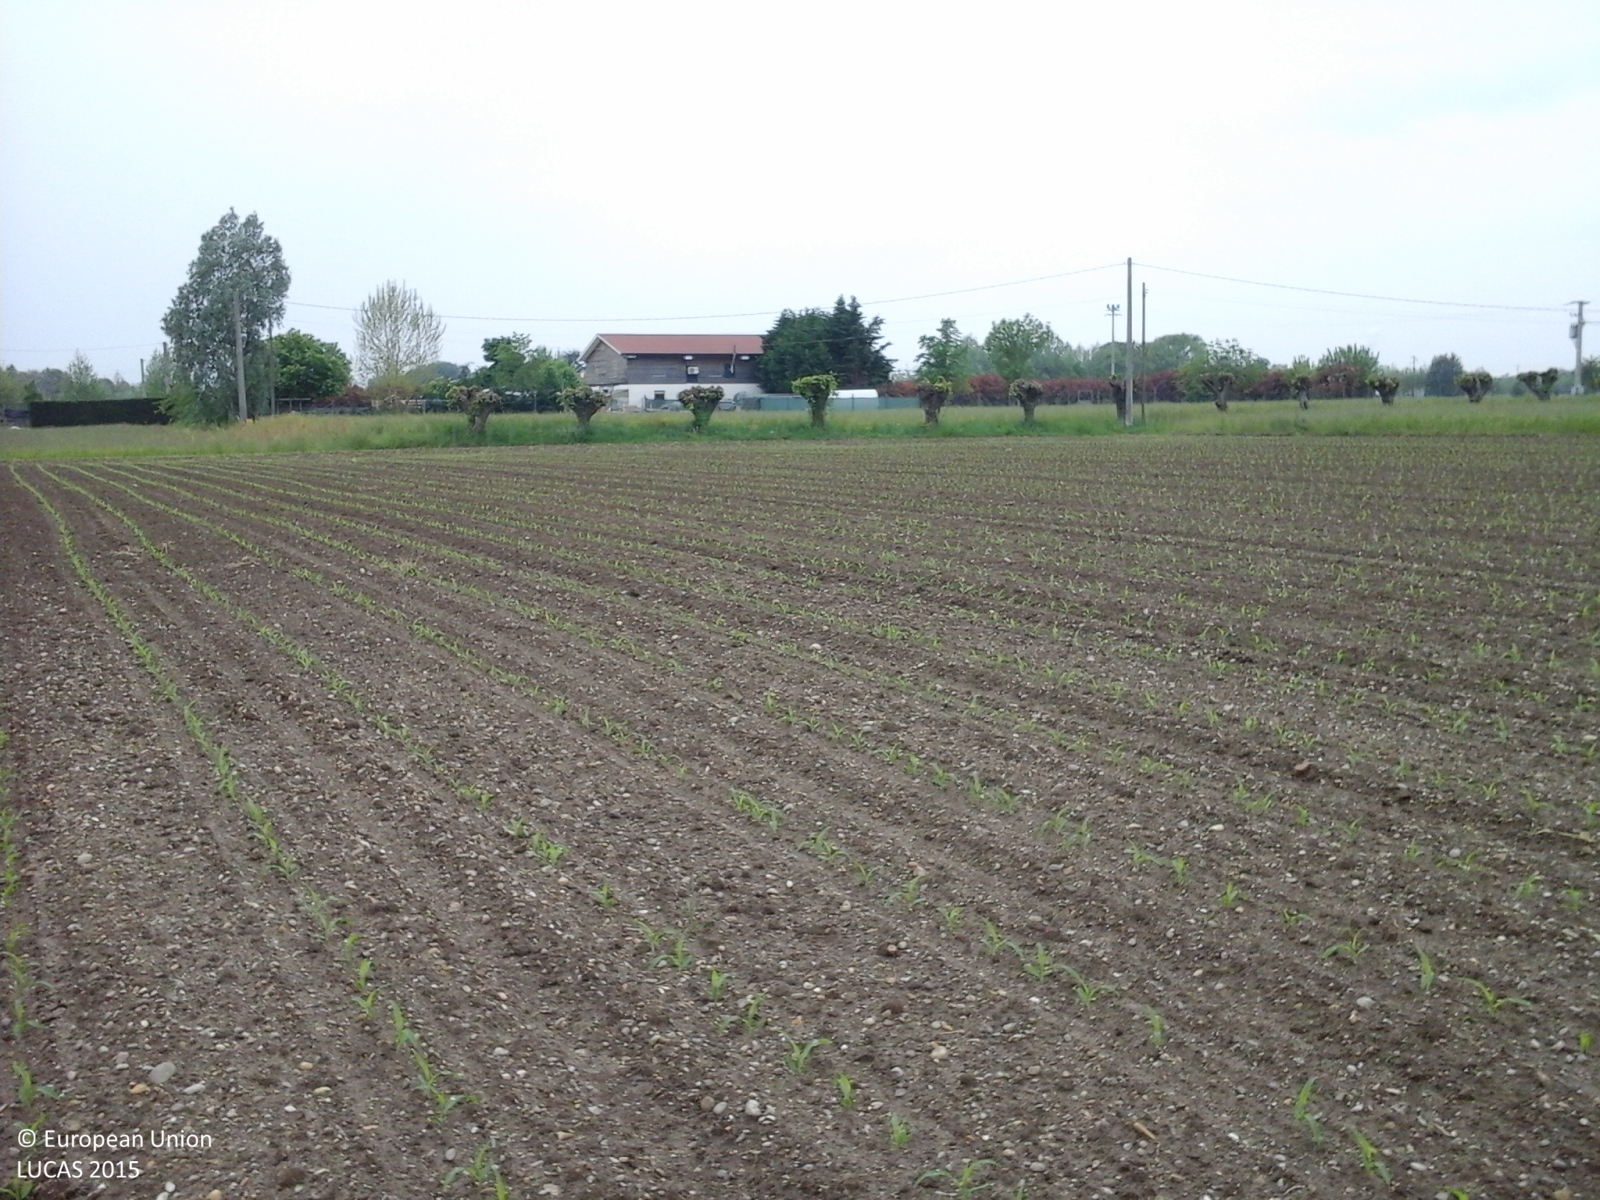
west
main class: Cropland
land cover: Maize
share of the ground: < 10 %
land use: Agriculture (excluding fallow land and kitchen gardens)
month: May
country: IT
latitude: 45.5083
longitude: 11.7251
